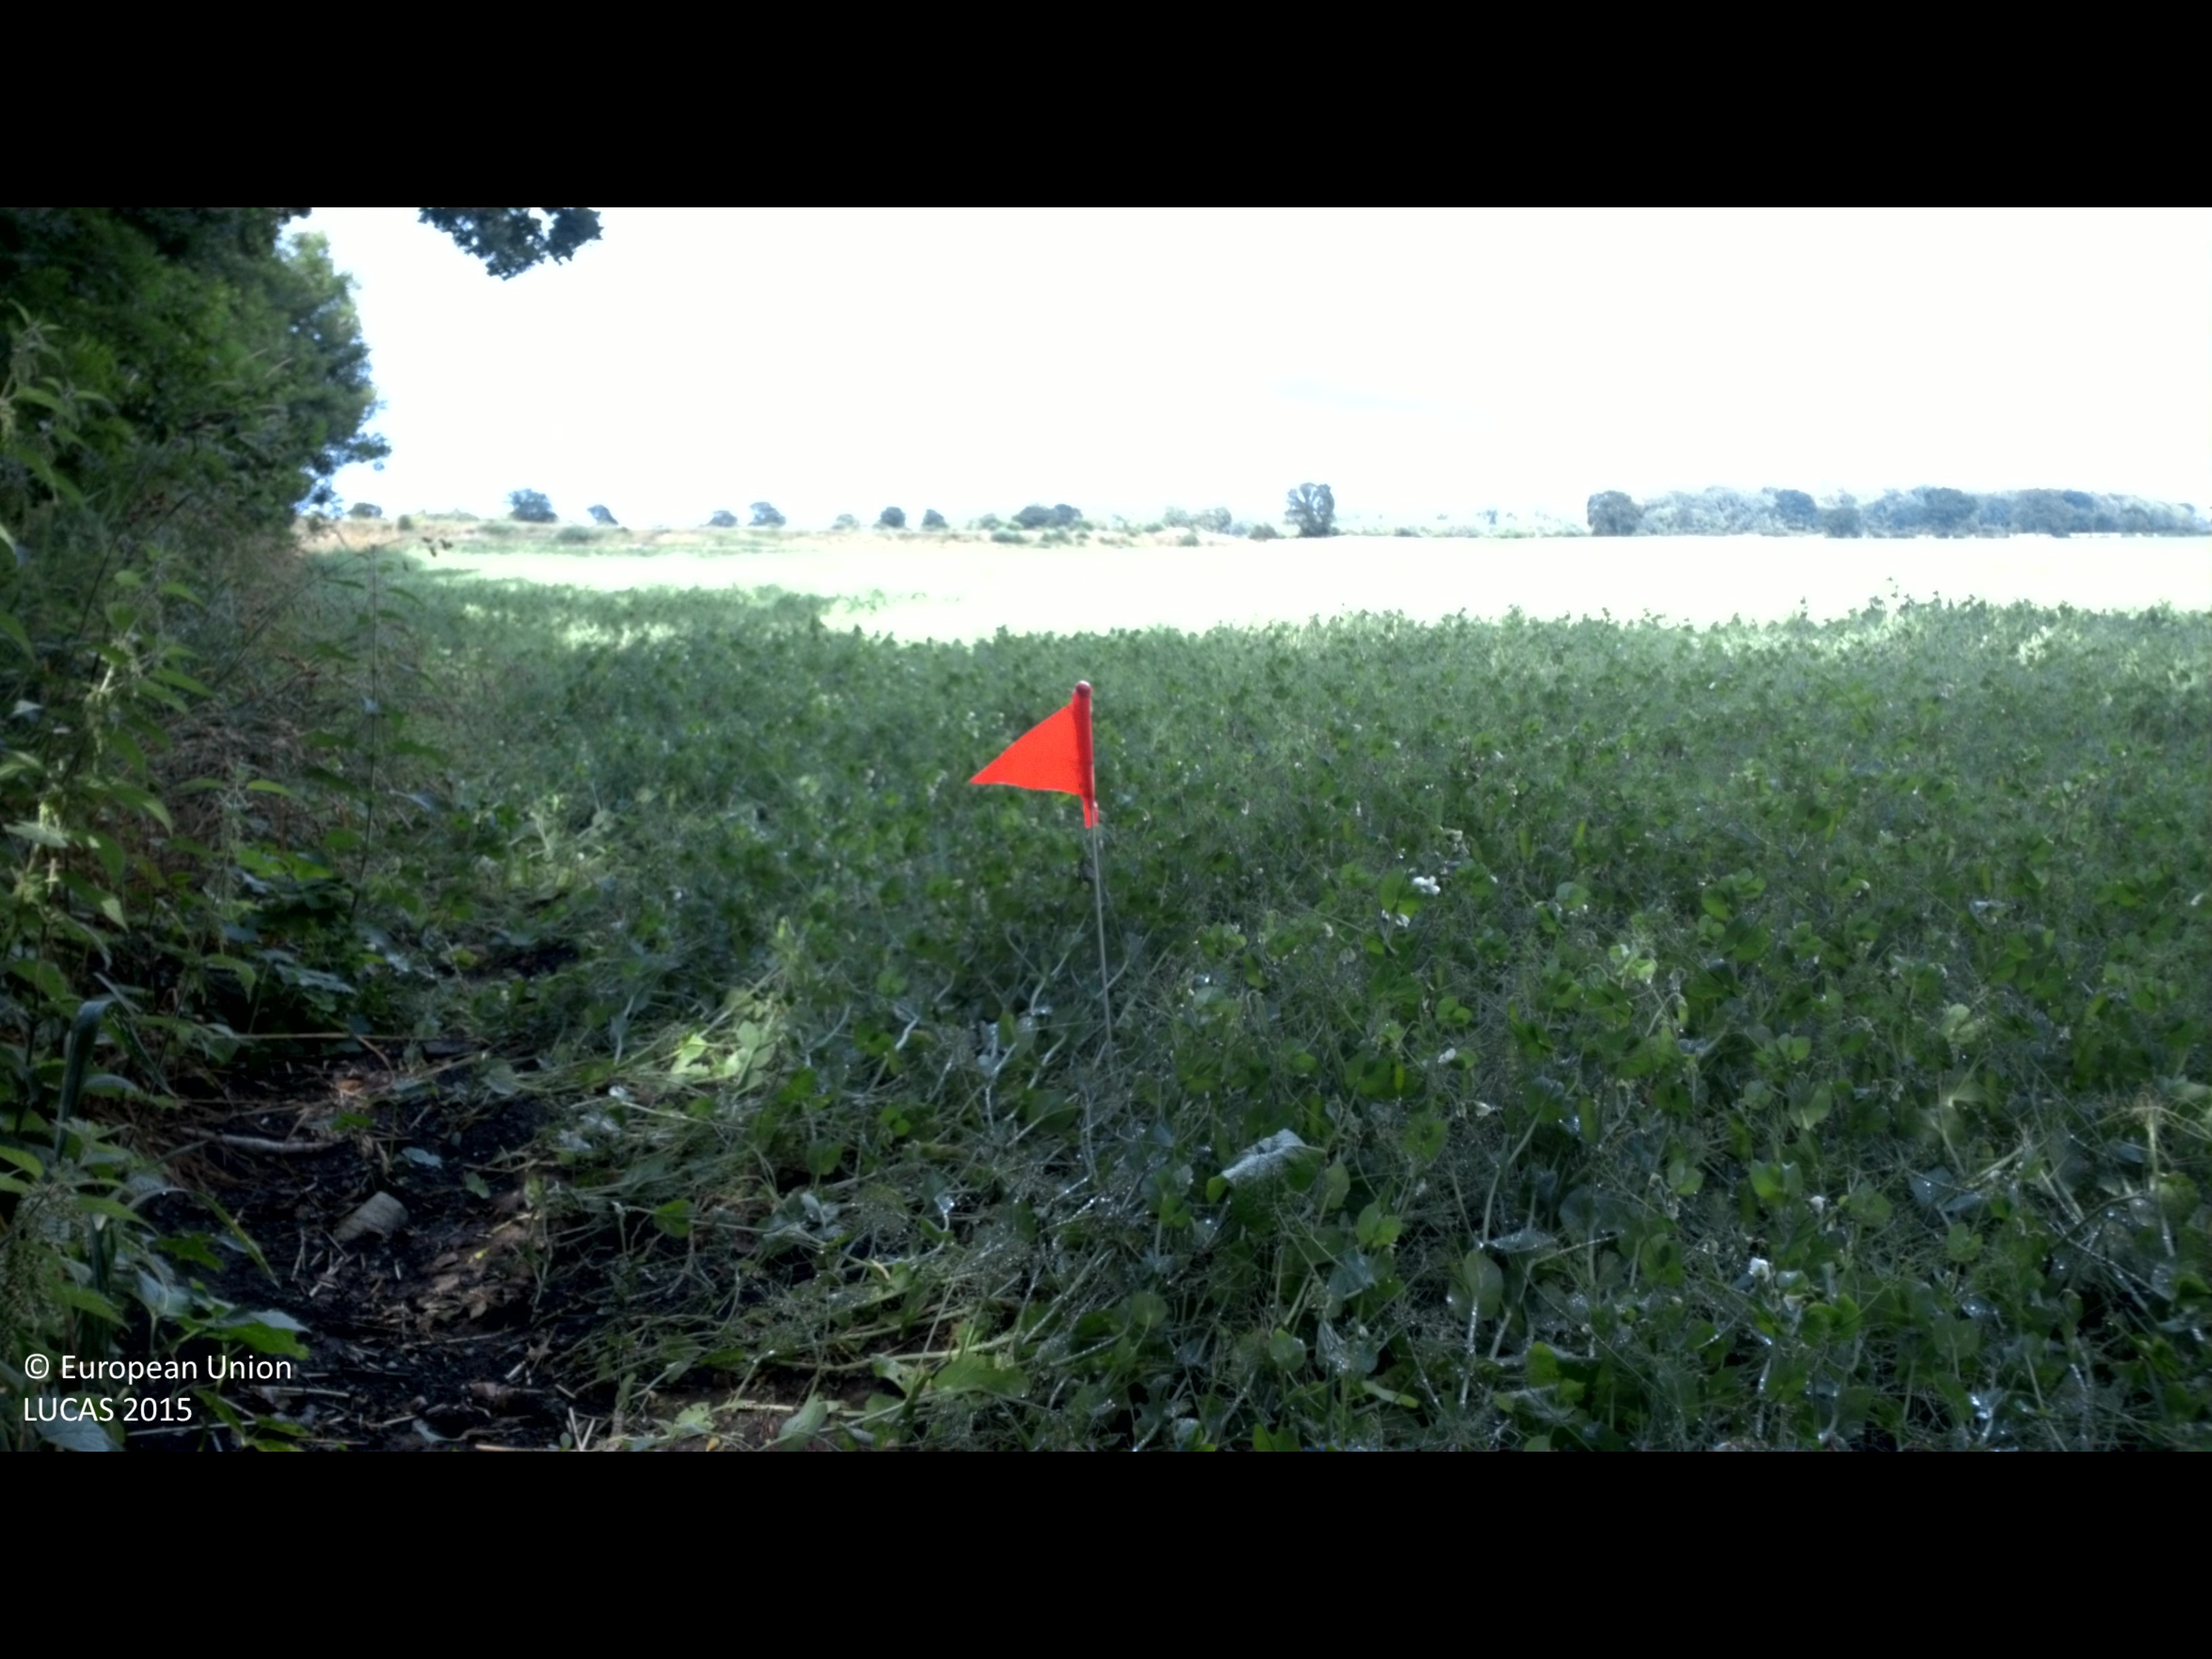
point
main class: Cropland
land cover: Dry pulses
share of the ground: > 75 %
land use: Agriculture (excluding fallow land and kitchen gardens)
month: July
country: SE
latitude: 56.6036
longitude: 16.4358
